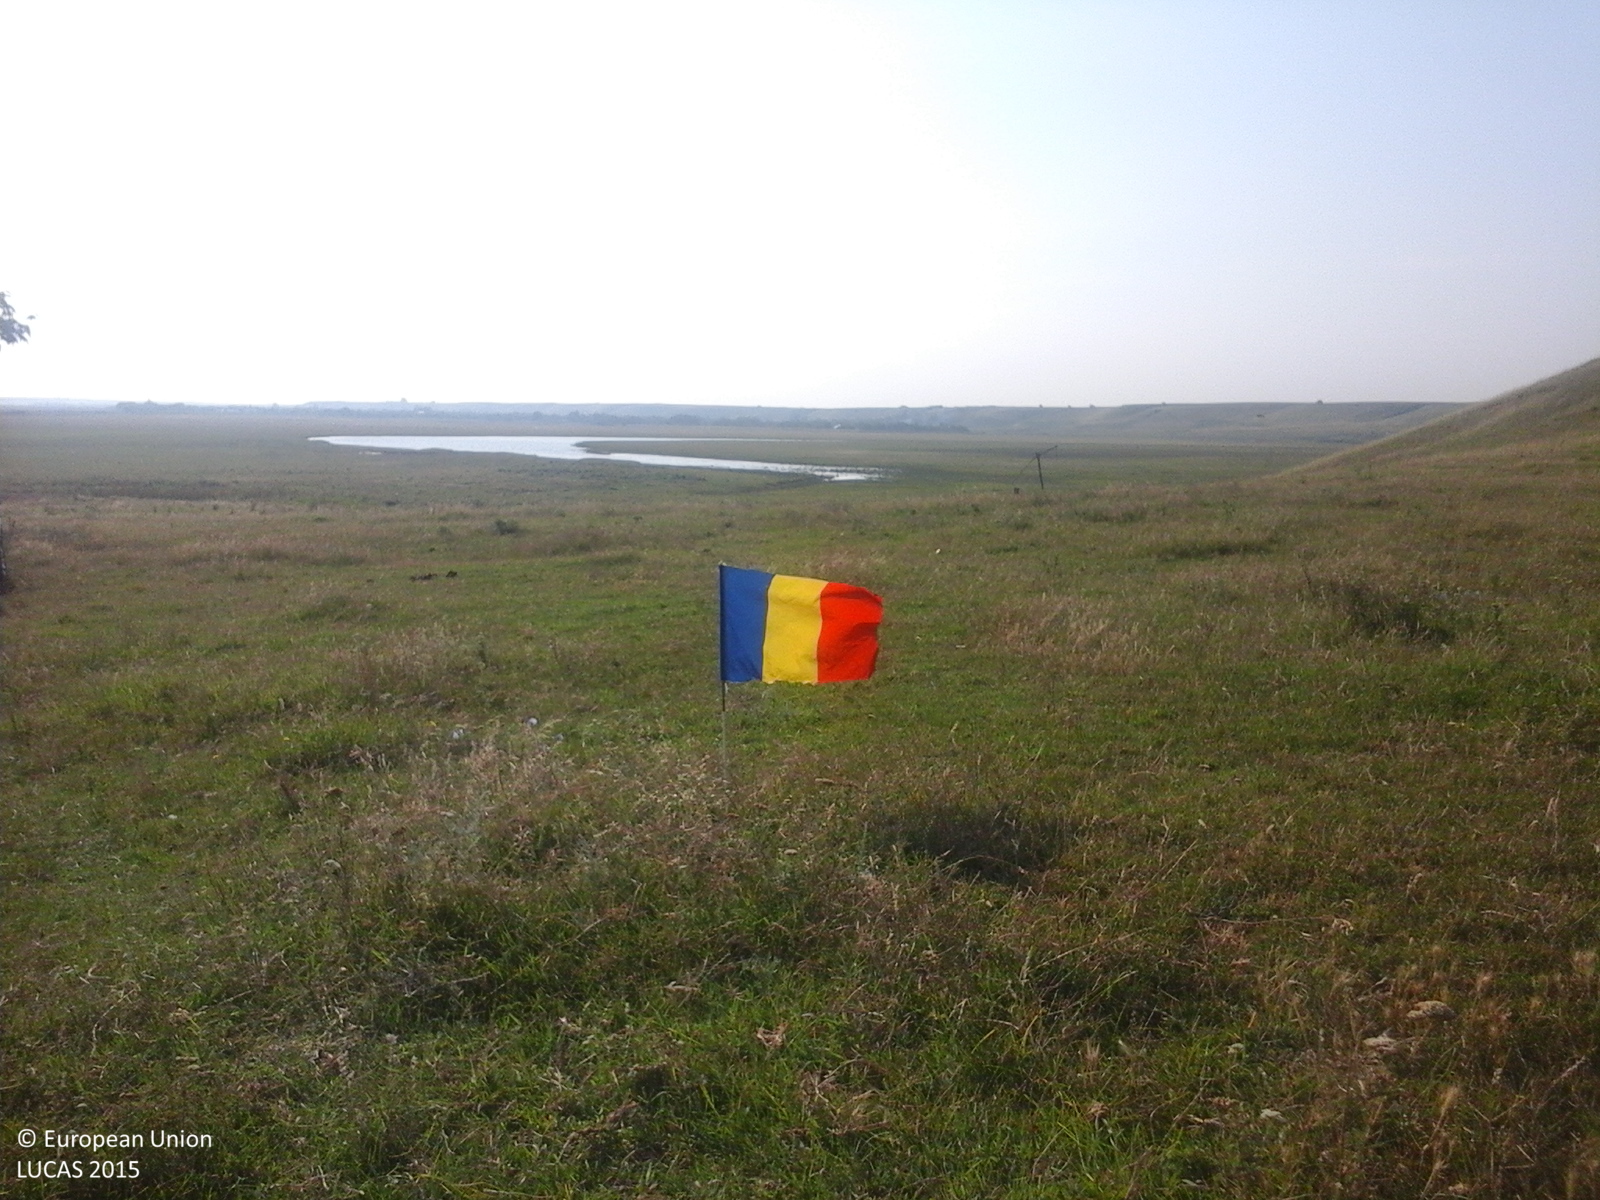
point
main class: Grassland
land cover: Grassland without tree/shrub cover
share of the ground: > 75 %
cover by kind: herbaceous plants 100 %
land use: Agriculture (excluding fallow land and kitchen gardens)
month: July
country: RO
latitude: 44.5445
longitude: 27.0599
